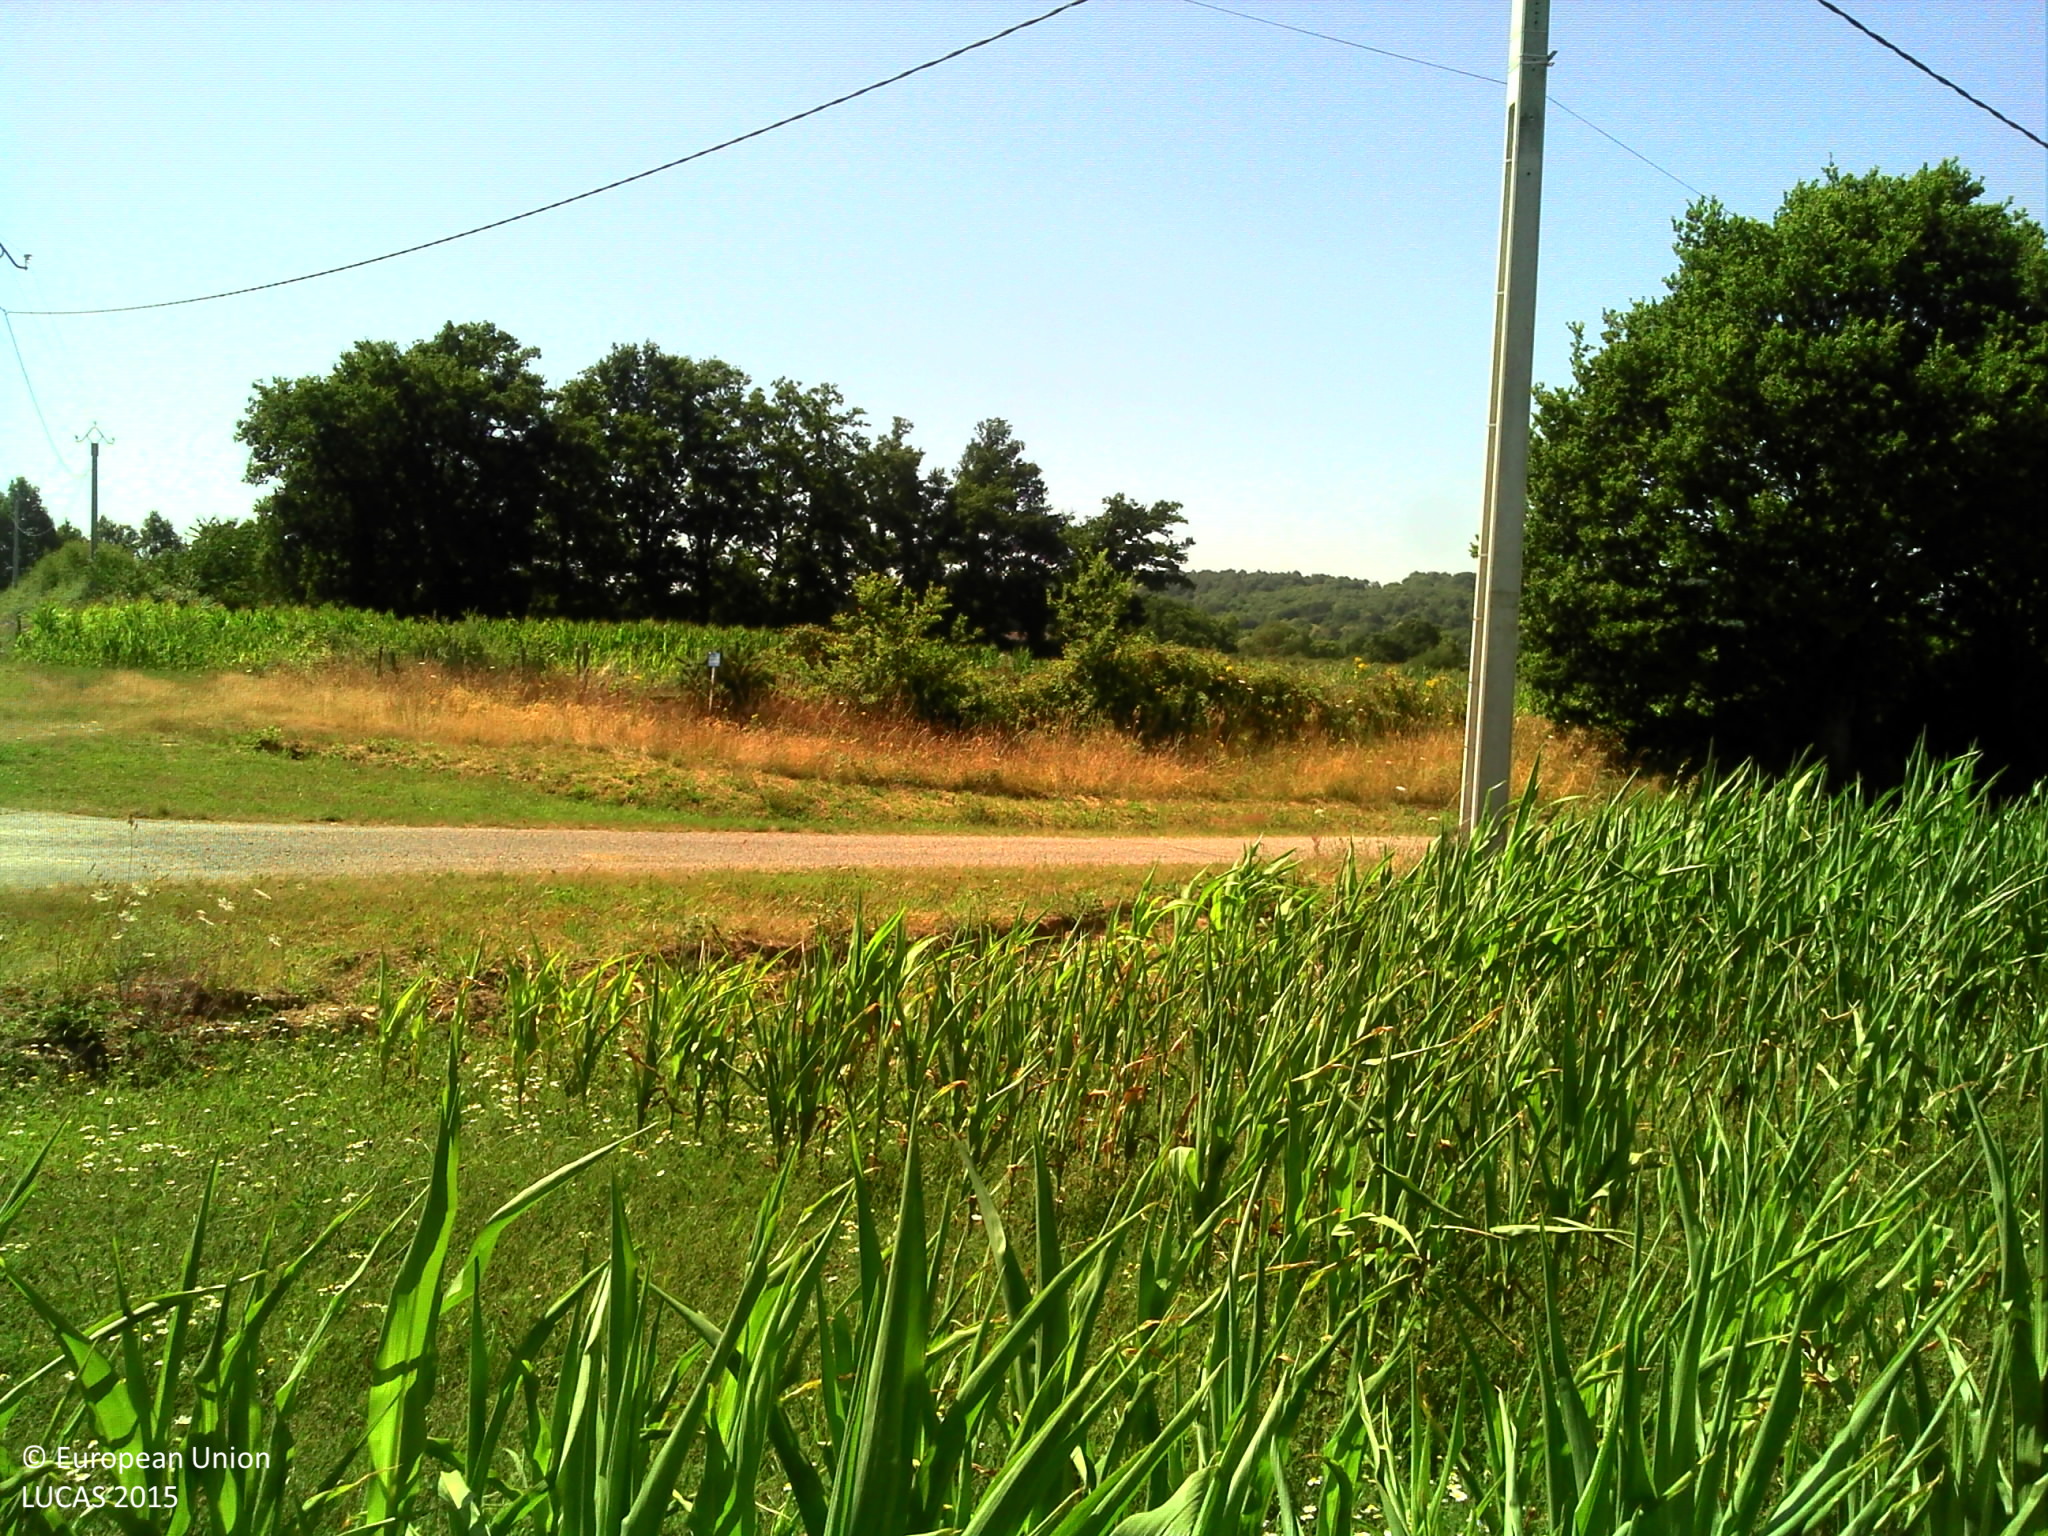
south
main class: Cropland
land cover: Maize
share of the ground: 50 - 75 %
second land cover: Spontaneously vegetated surfaces
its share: 10 - 25 %
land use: Agriculture (excluding fallow land and kitchen gardens)
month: July
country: FR
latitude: 47.7127
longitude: -1.8176
